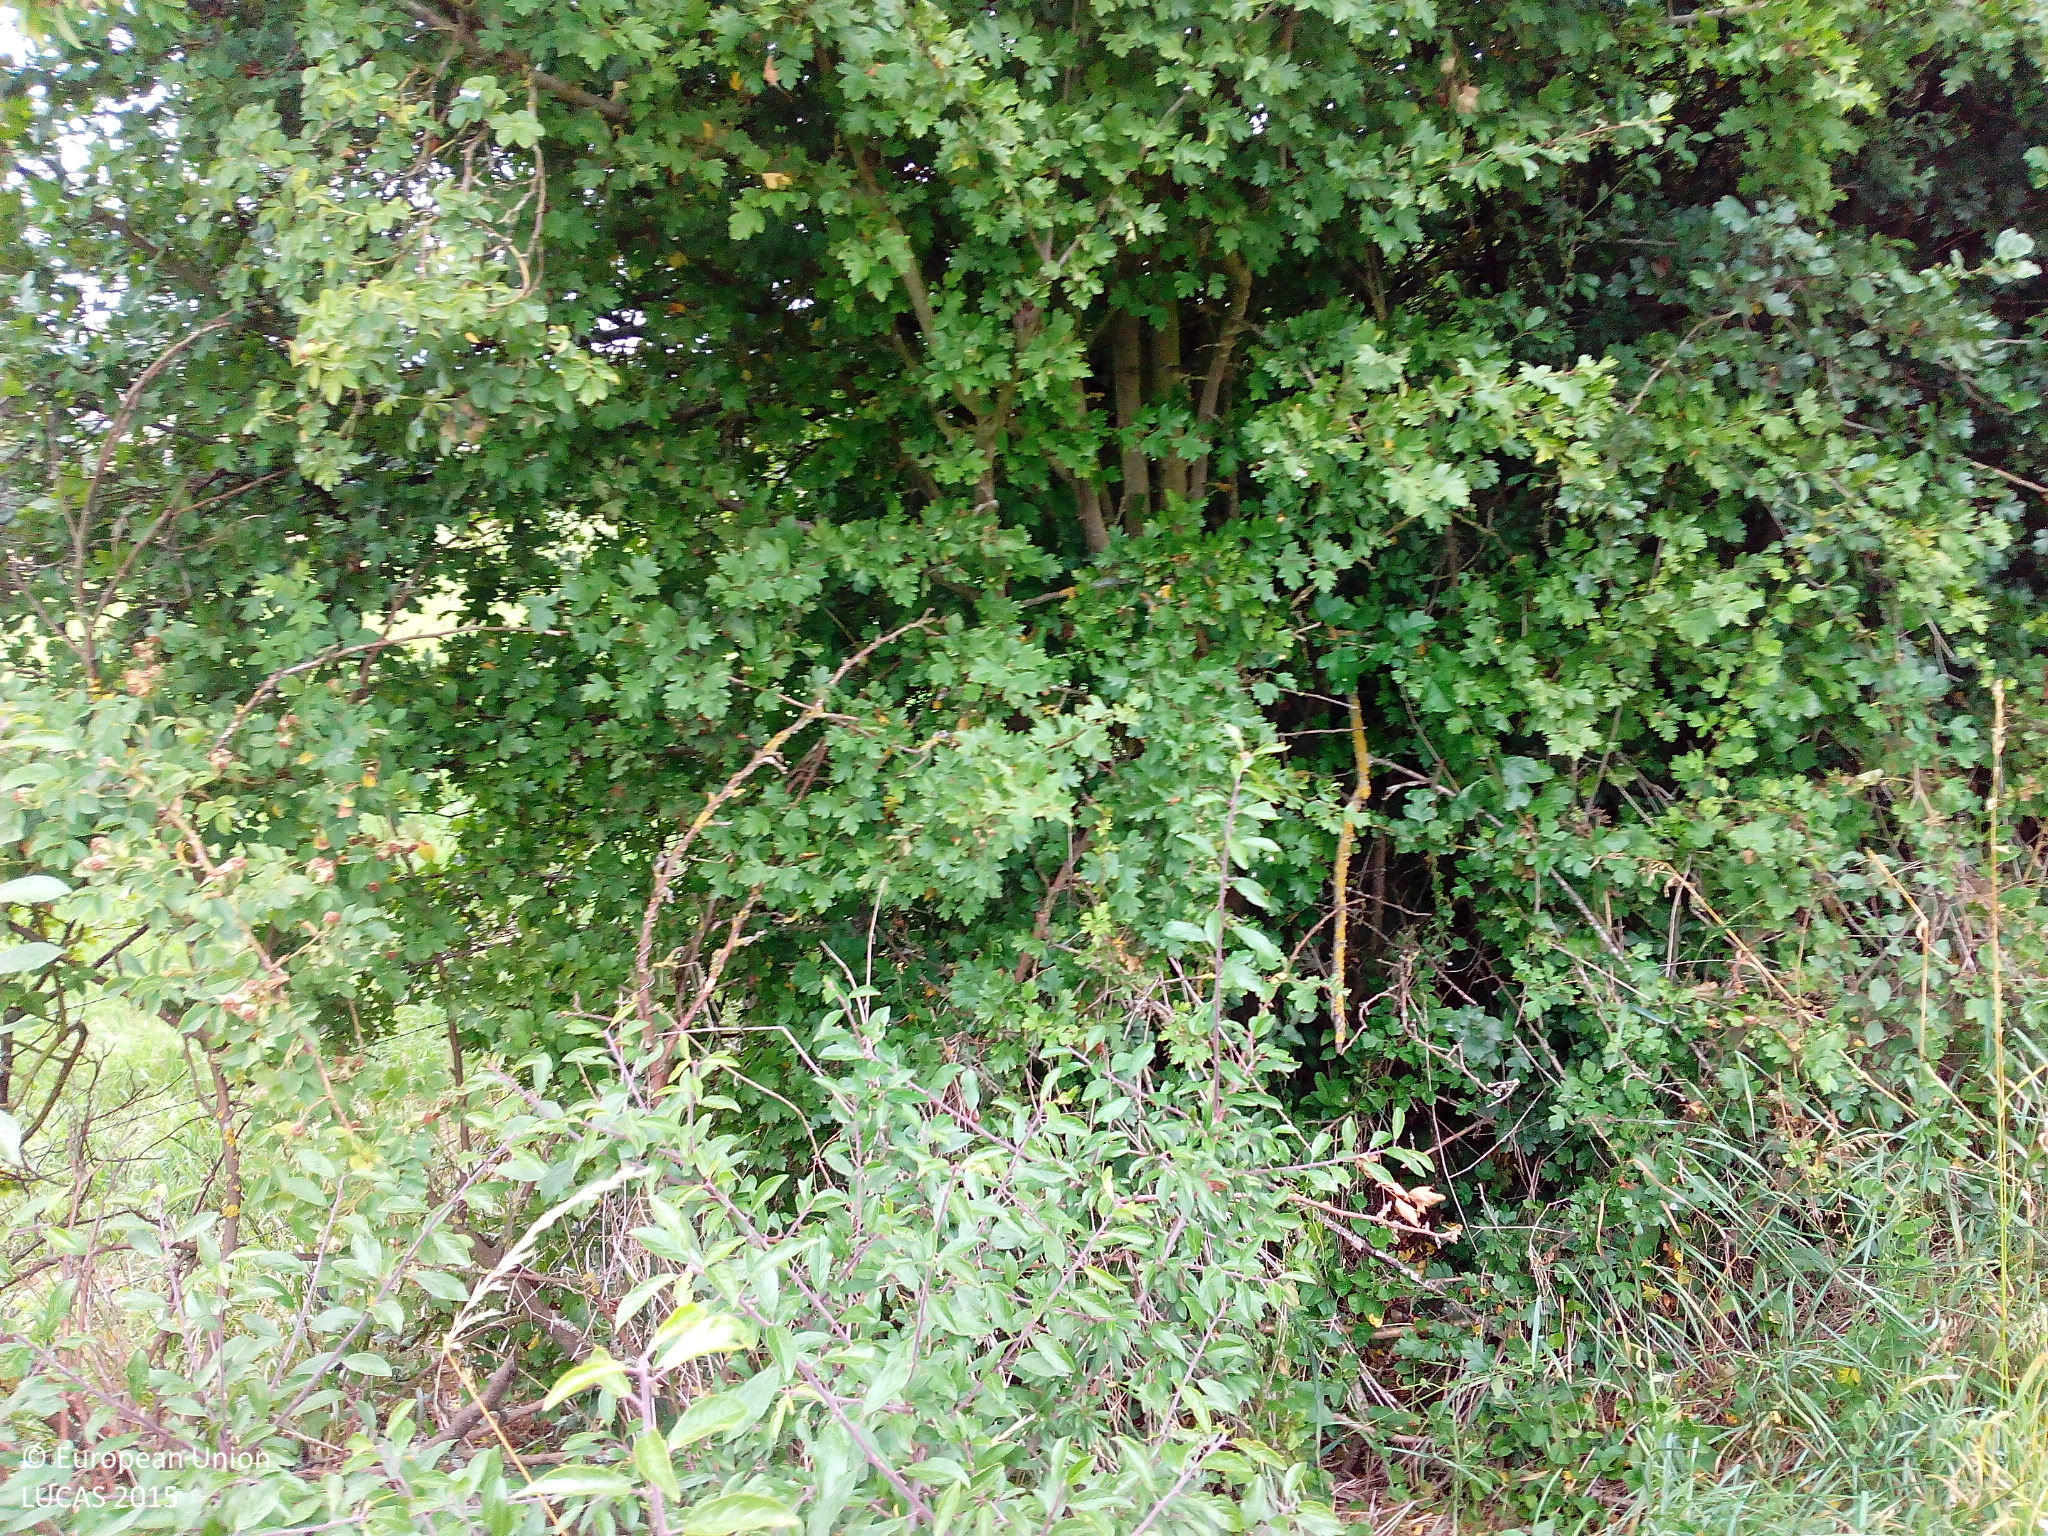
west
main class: Grassland
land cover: Grassland without tree/shrub cover
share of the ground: > 75 %
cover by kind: herbaceous plants 100 %
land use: Agriculture (excluding fallow land and kitchen gardens)
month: July
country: DE
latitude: 50.7775
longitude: 9.8724
